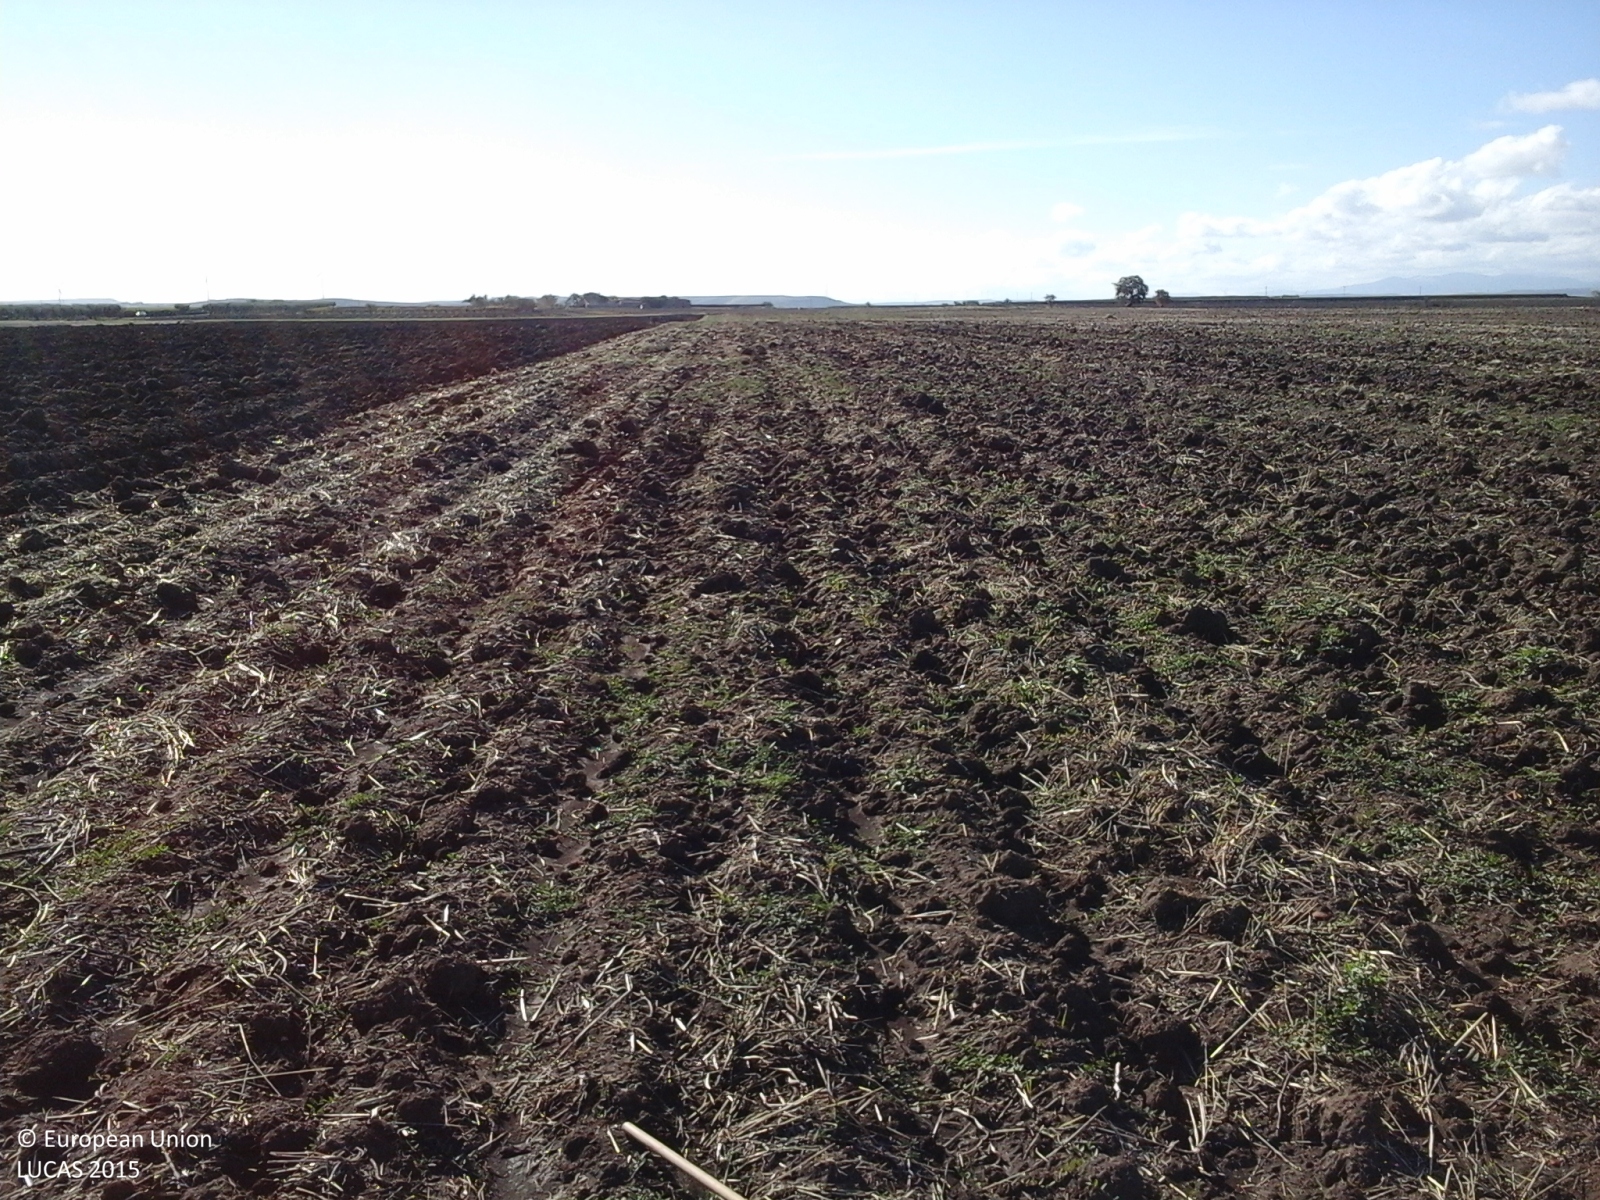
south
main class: Cropland
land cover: Dry pulses
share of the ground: > 75 %
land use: Agriculture (excluding fallow land and kitchen gardens)
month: September
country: IT
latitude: 41.6705
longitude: 15.1840
